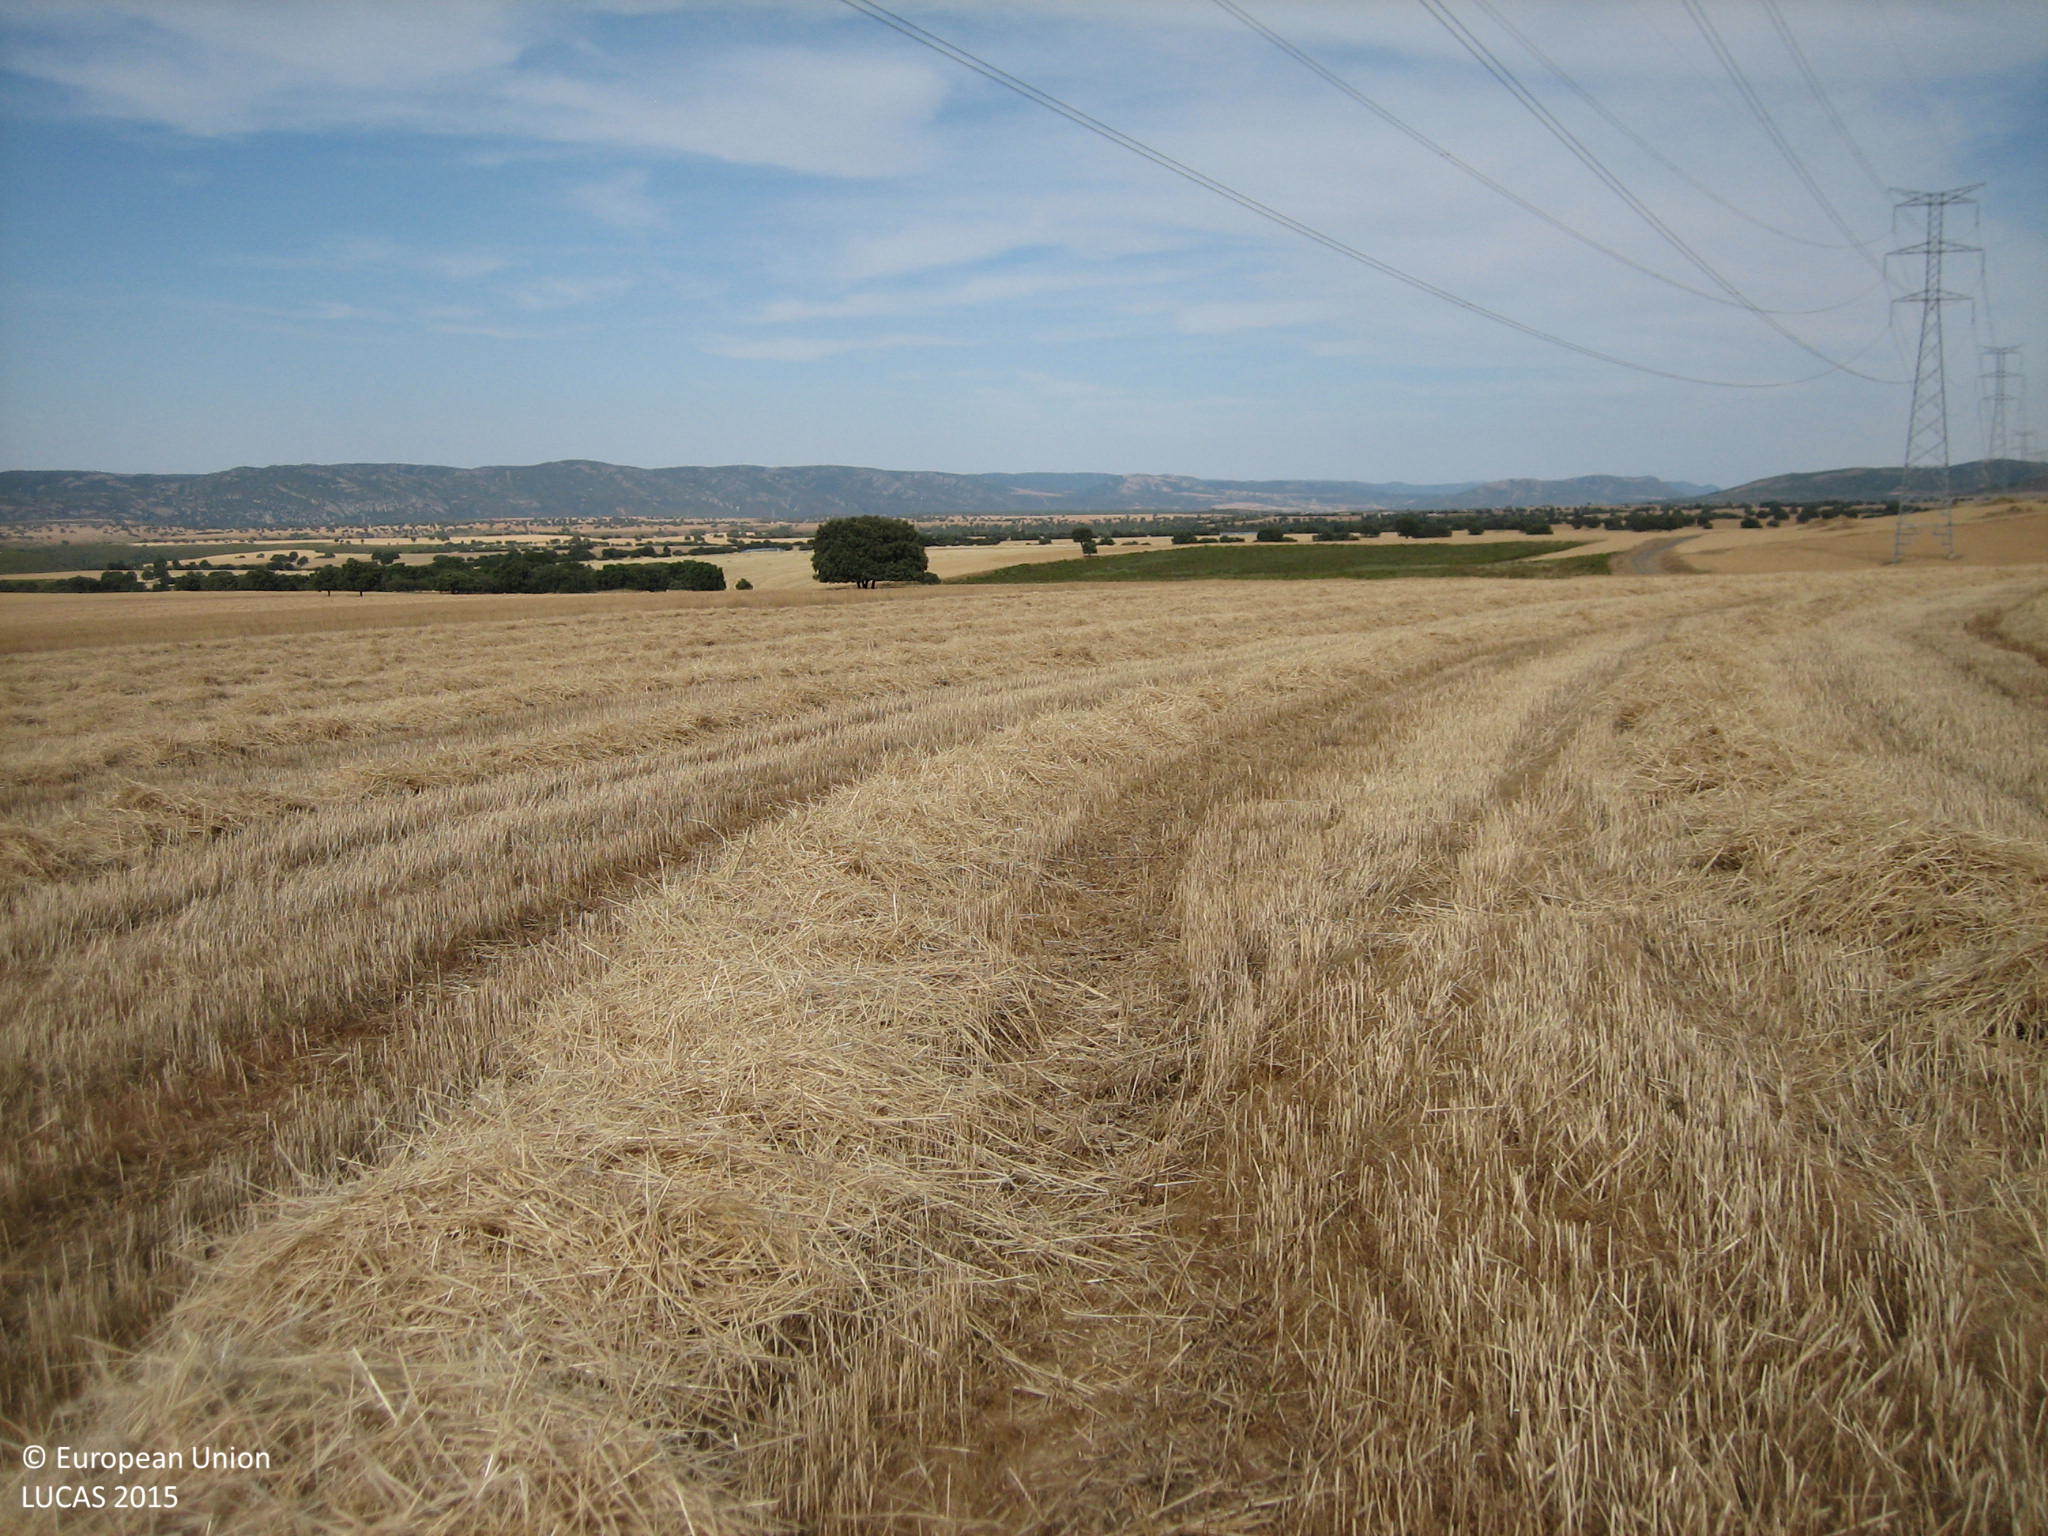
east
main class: Cropland
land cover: Durum wheat
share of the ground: 10 - 25 %
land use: Agriculture (excluding fallow land and kitchen gardens)
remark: Harvested field
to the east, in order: Durum wheat; Electric lines; Durum wheat; Paved roads, cycling and walking lanes; Durum wheat
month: June
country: ES
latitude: 39.0939
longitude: -4.7283
